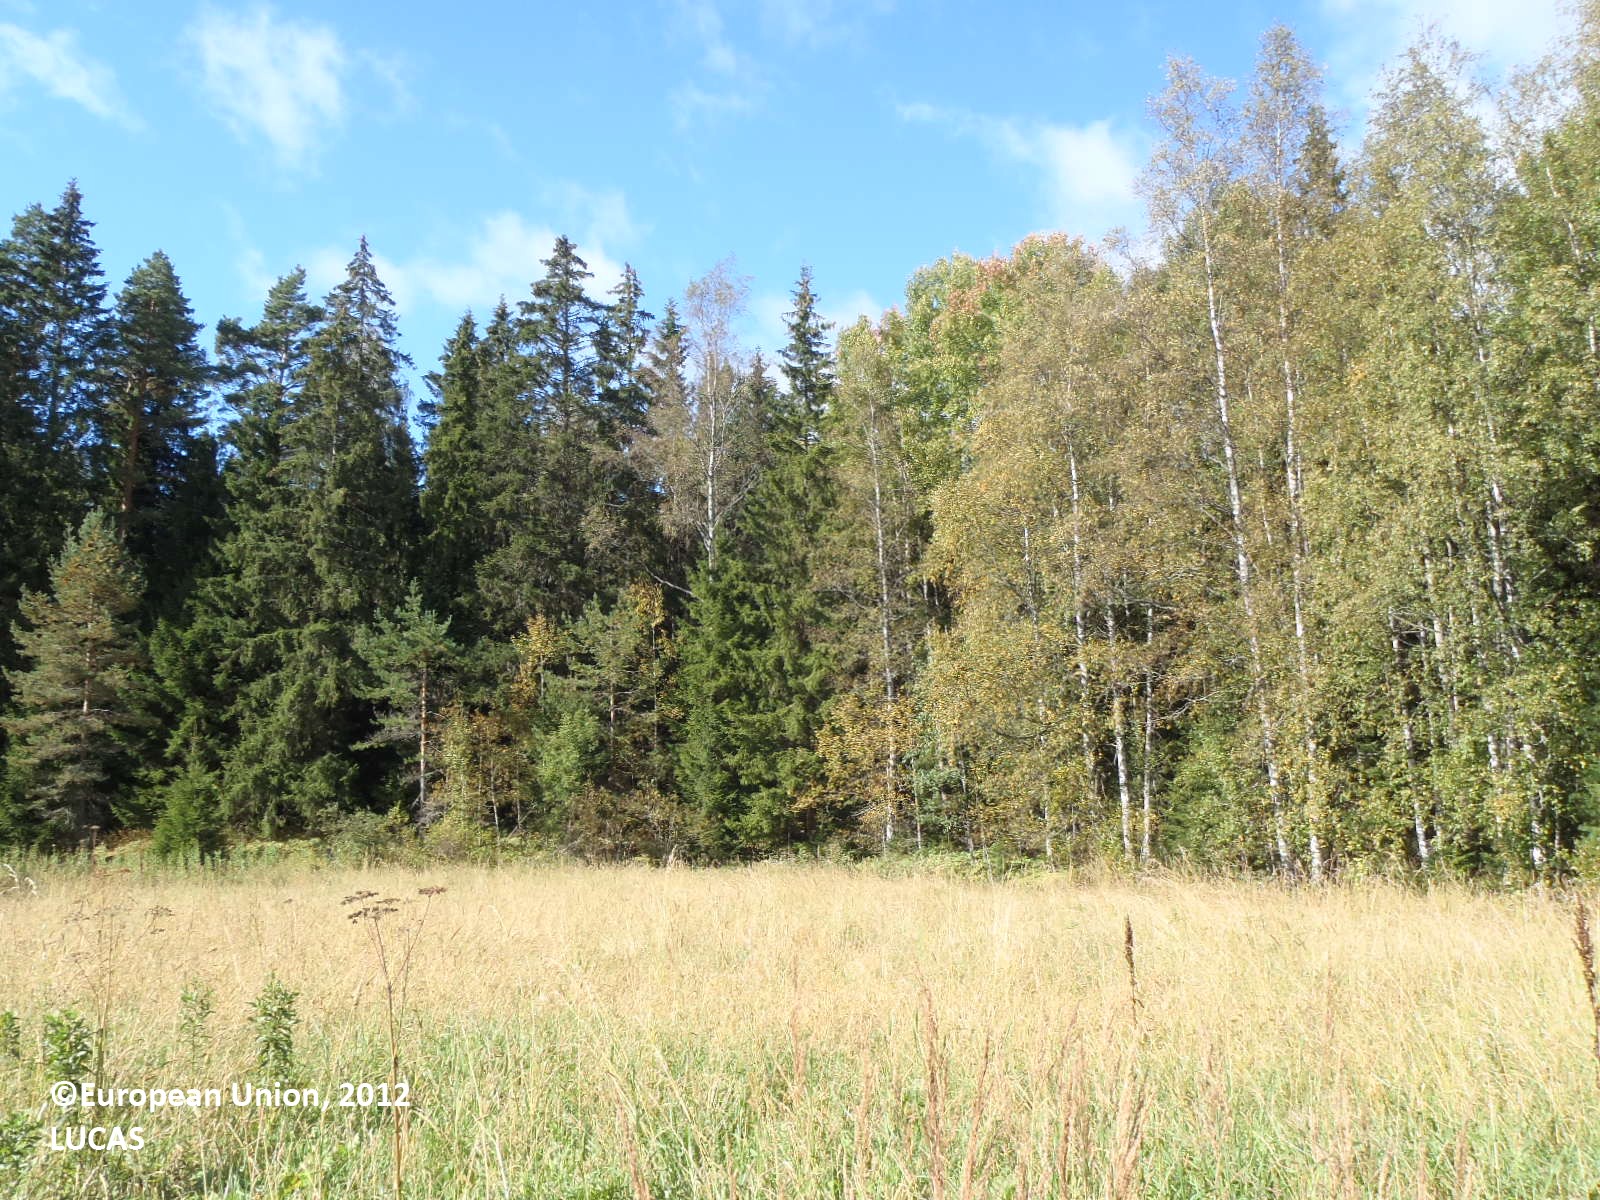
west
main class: Grassland
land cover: Grassland without tree/shrub cover
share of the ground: > 75 %
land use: Residential
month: September
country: FI
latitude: 61.3591
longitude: 22.6913
